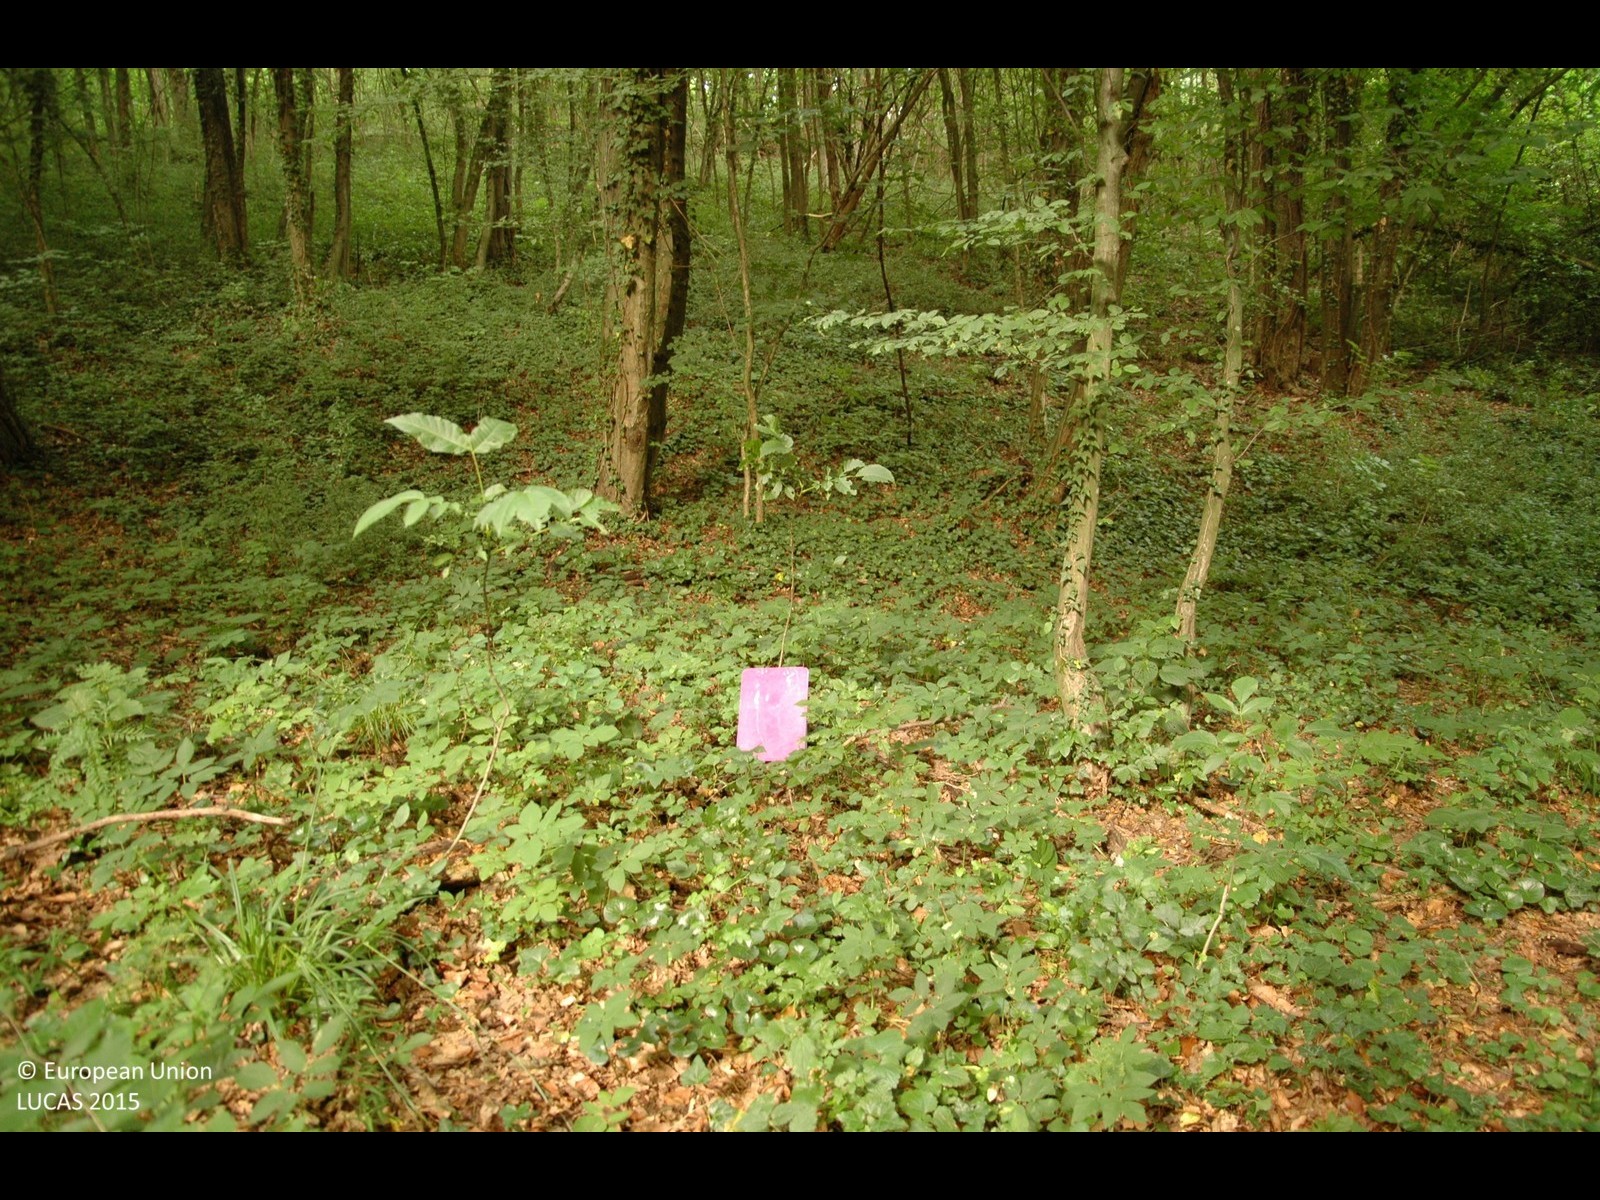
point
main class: Woodland
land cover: Broadleaved woodland
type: mesophytic deciduous forest
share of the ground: > 75 %
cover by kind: broadleaved forest trees 100 %
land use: Forestry
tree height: > 5 m
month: June
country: HR
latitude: 46.2275
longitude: 16.4702
